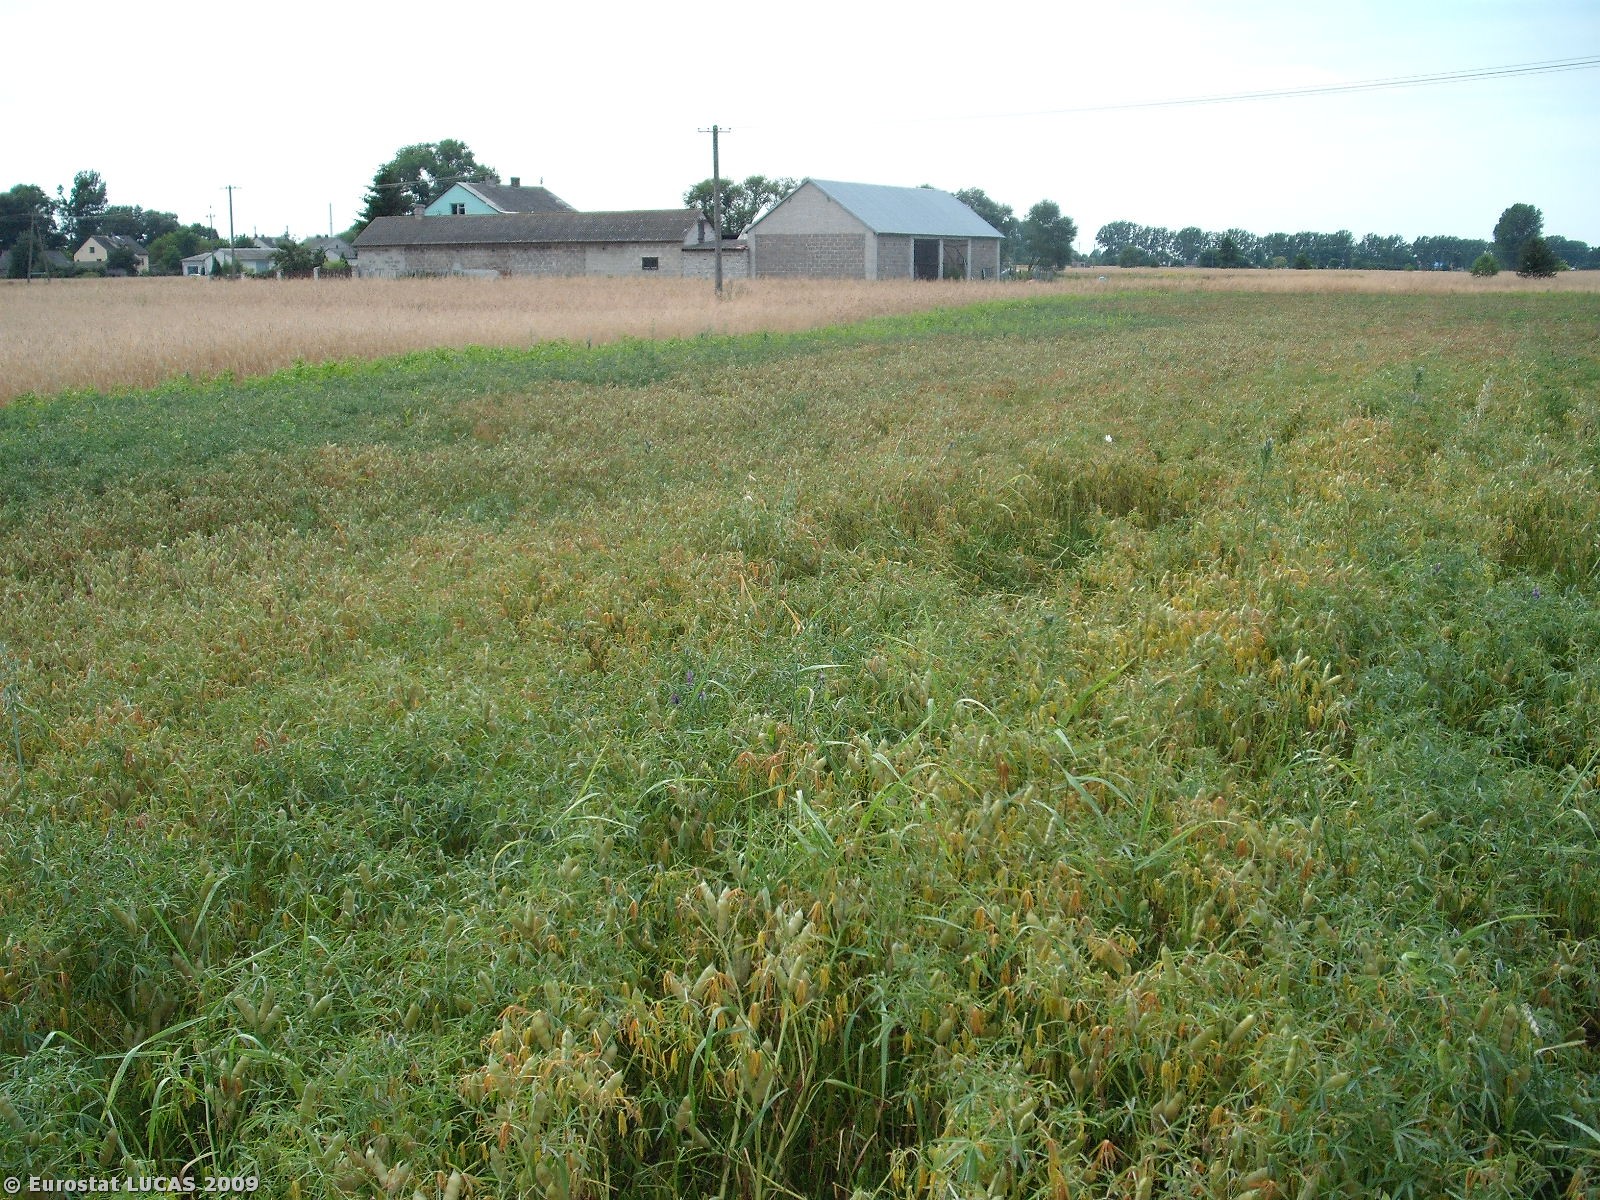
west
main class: Cropland
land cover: Dry pulses
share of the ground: > 75 %
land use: Agriculture (excluding fallow land and kitchen gardens)
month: July
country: PL
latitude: 51.6814
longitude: 21.5794
